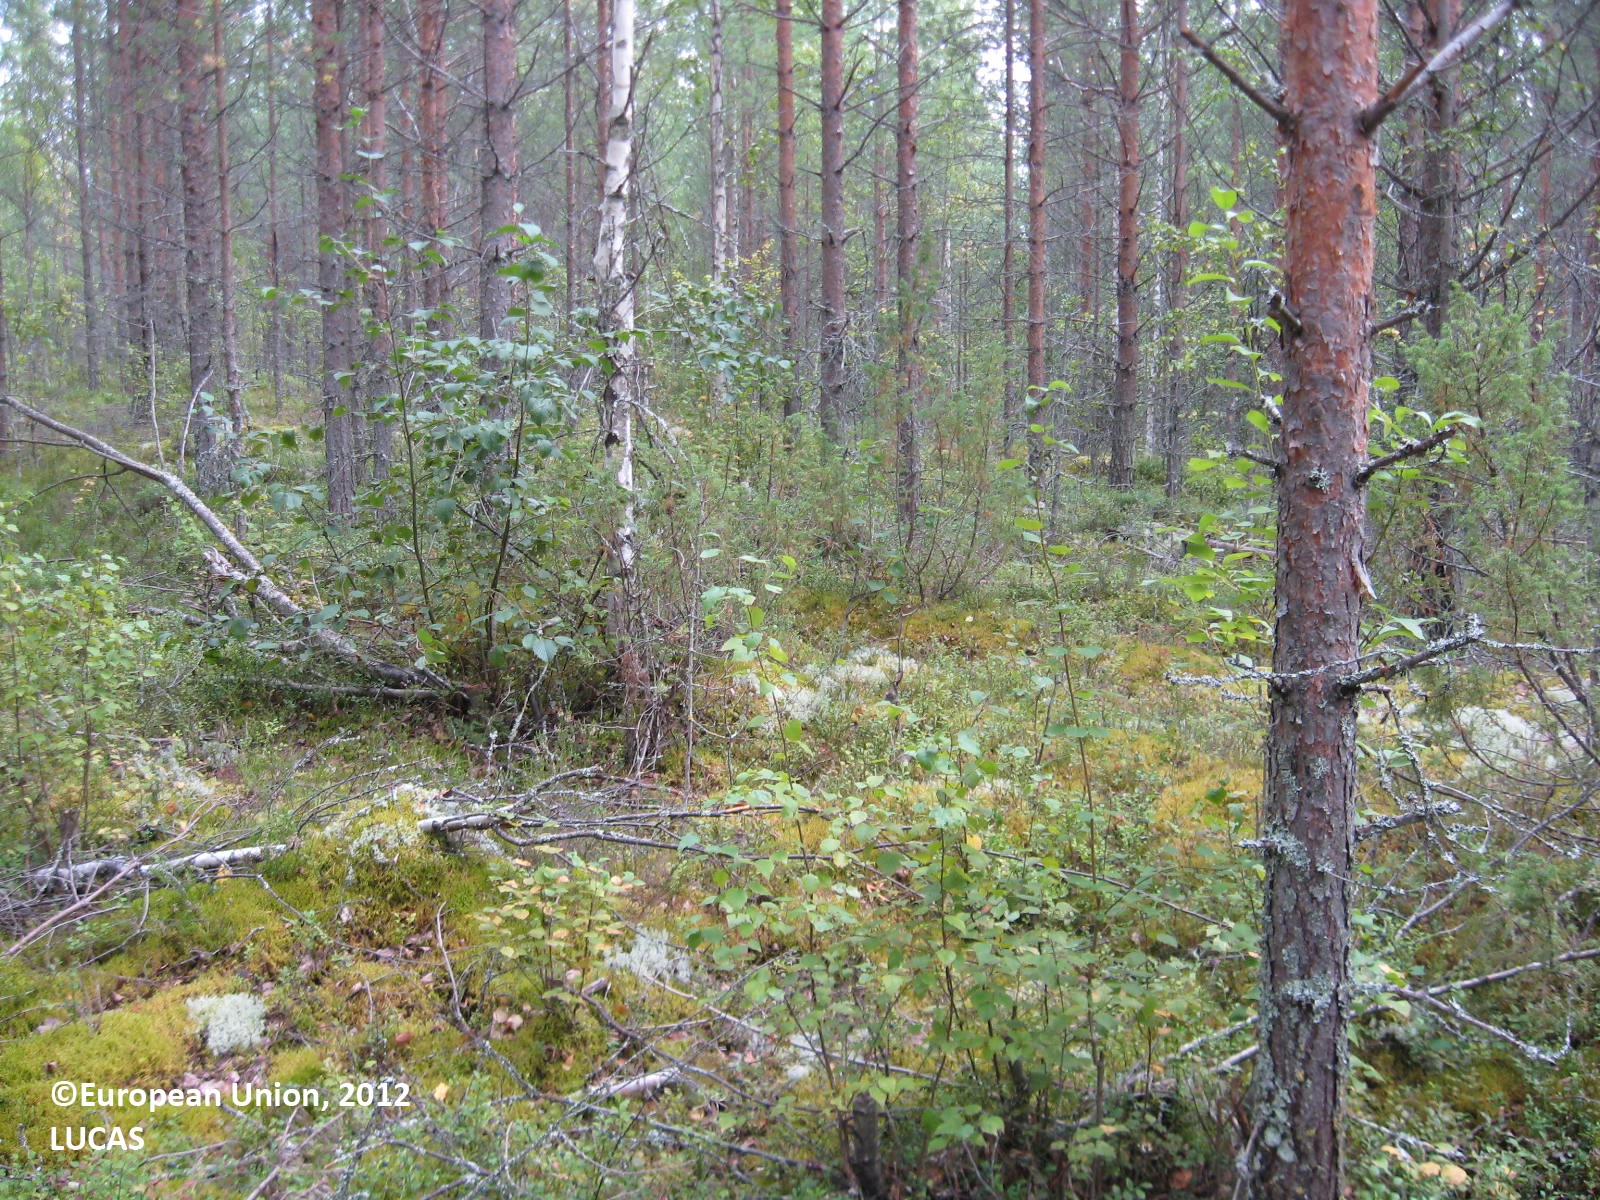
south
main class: Woodland
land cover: Pine dominated mixed woodland
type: boreal forest
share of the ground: > 75 %
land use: Forestry
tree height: > 5 m
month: August
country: FI
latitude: 63.3924
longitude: 30.2110
